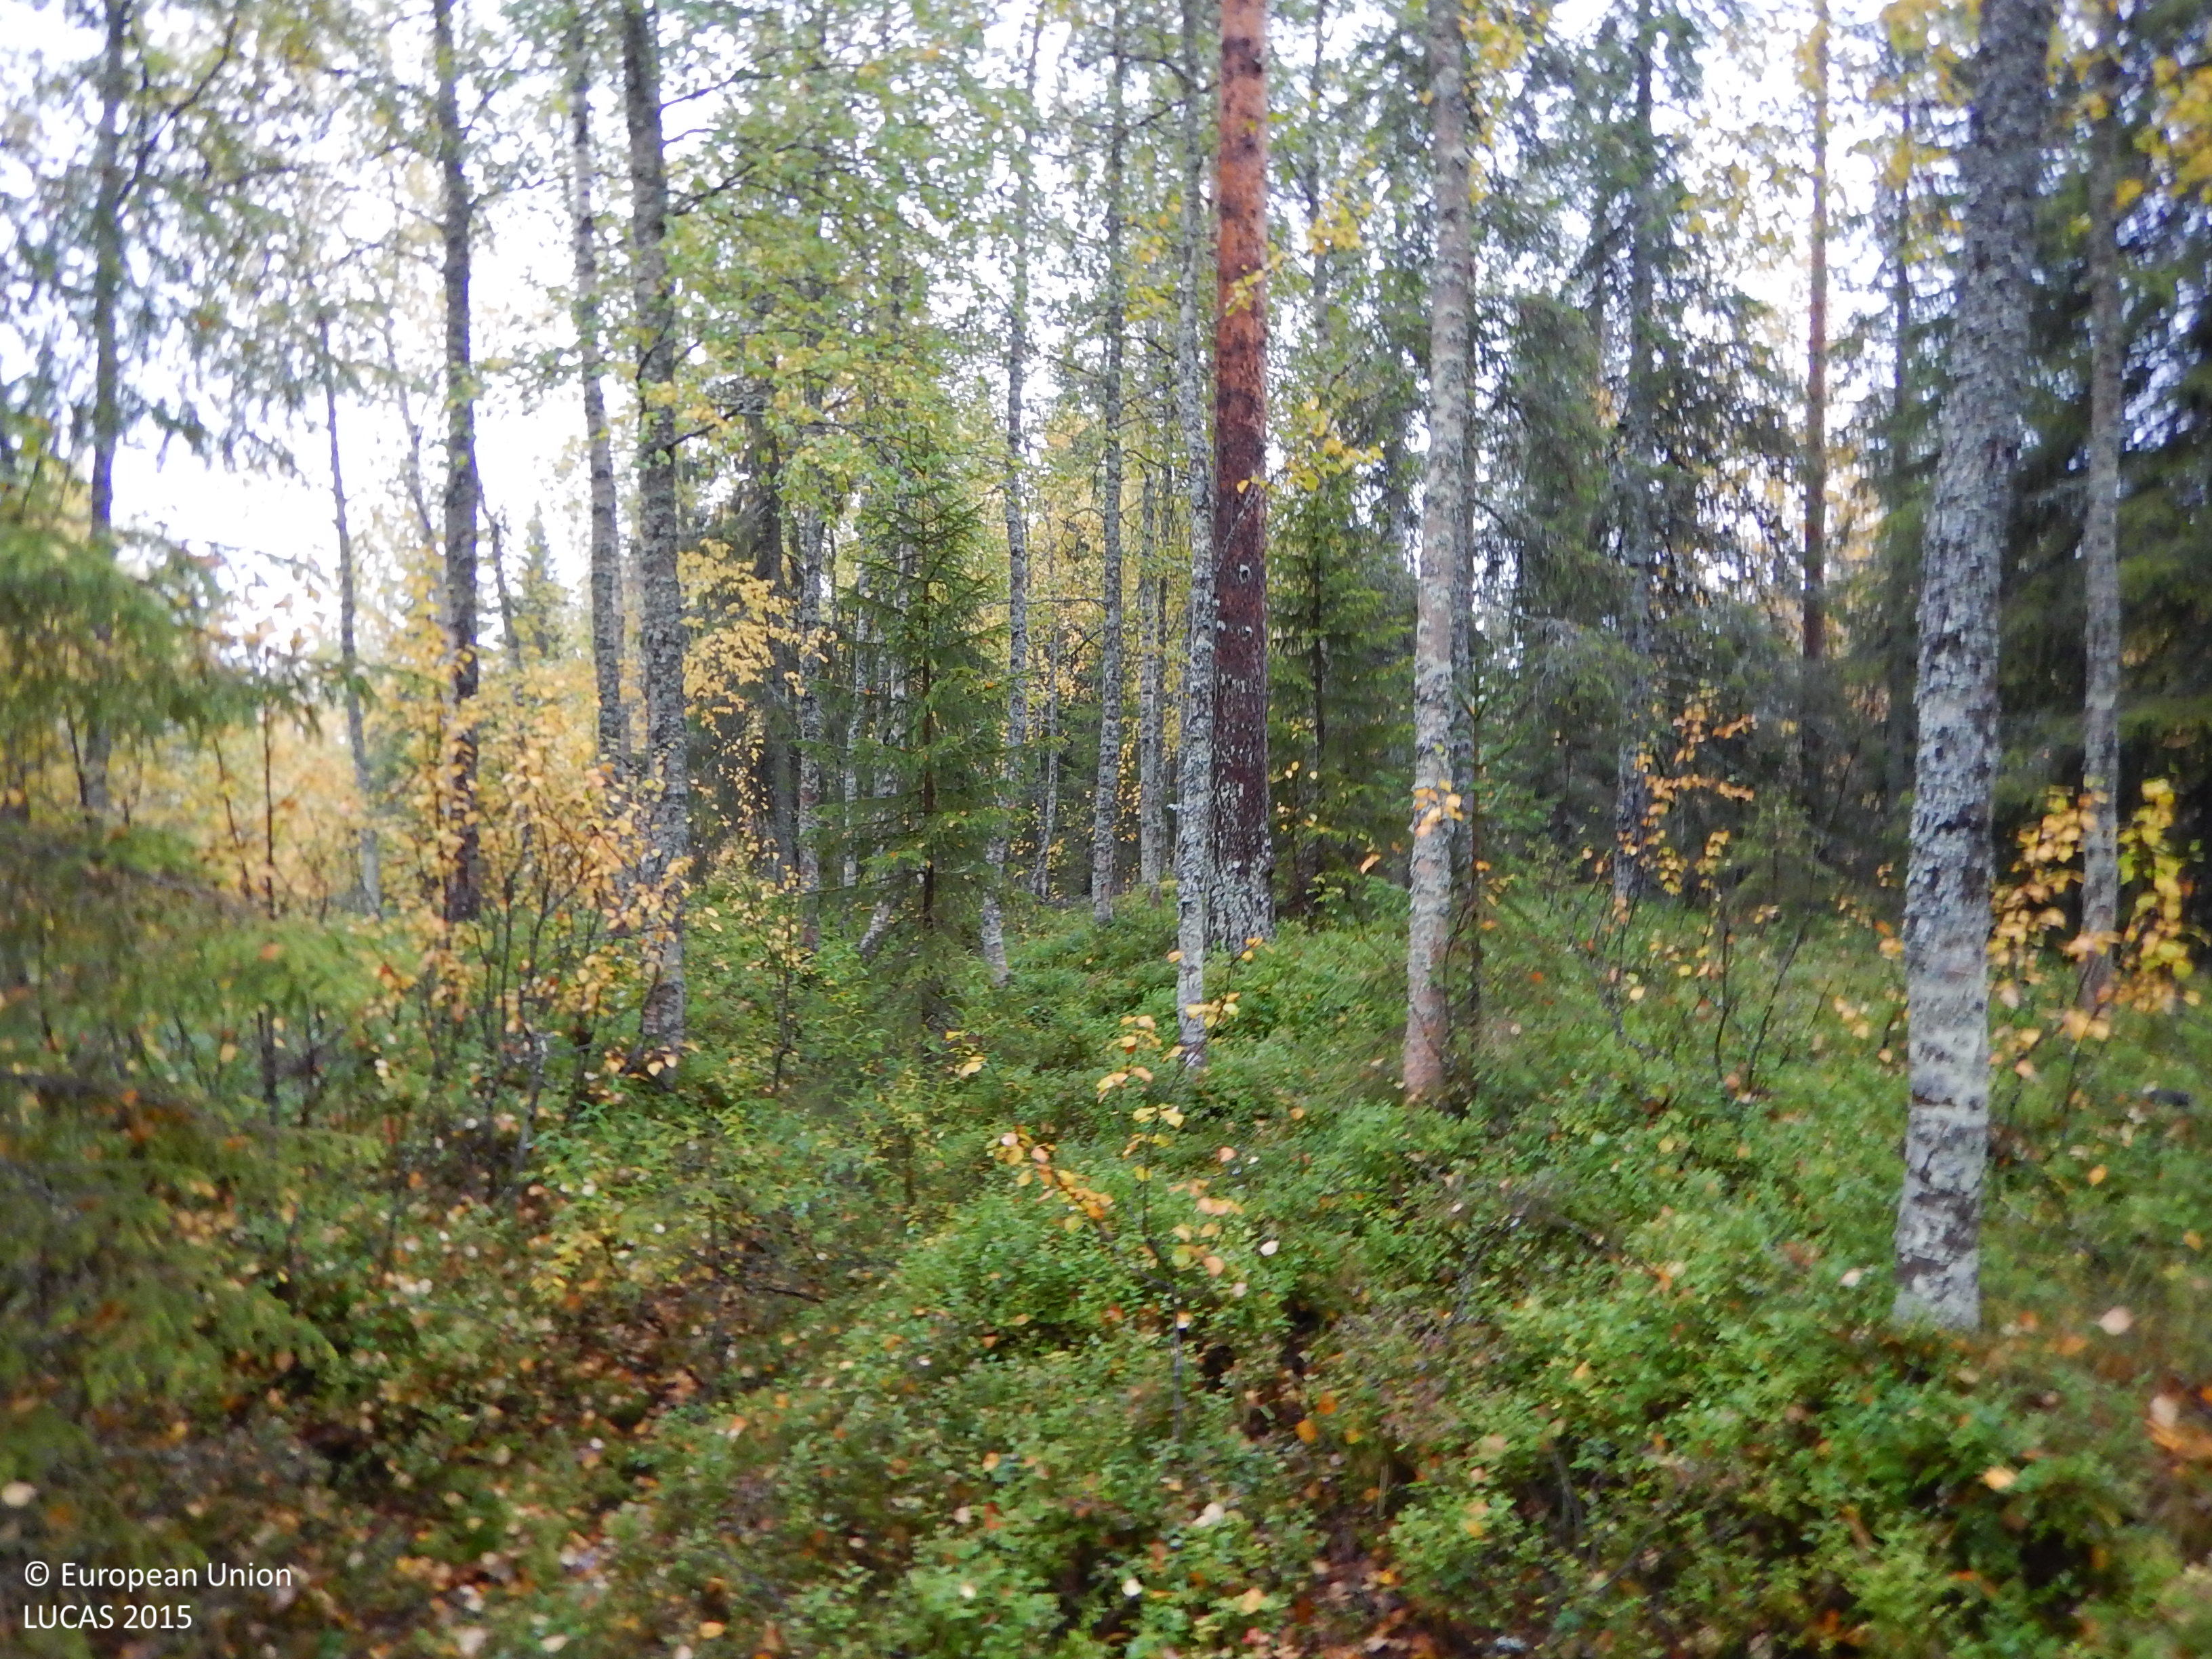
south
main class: Woodland
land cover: Spruce dominated mixed woodland
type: boreal forest
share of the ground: 25 - 50 %
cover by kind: coniferous forest trees 30 %, herbaceous plants 20 %, lichens and mosses 20 %, broadleaved forest trees 15 %, shrubs 15 %
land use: Forestry
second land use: Amenities, museums, leisure
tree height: > 5 m
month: September
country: SE
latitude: 65.0324
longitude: 19.0314
